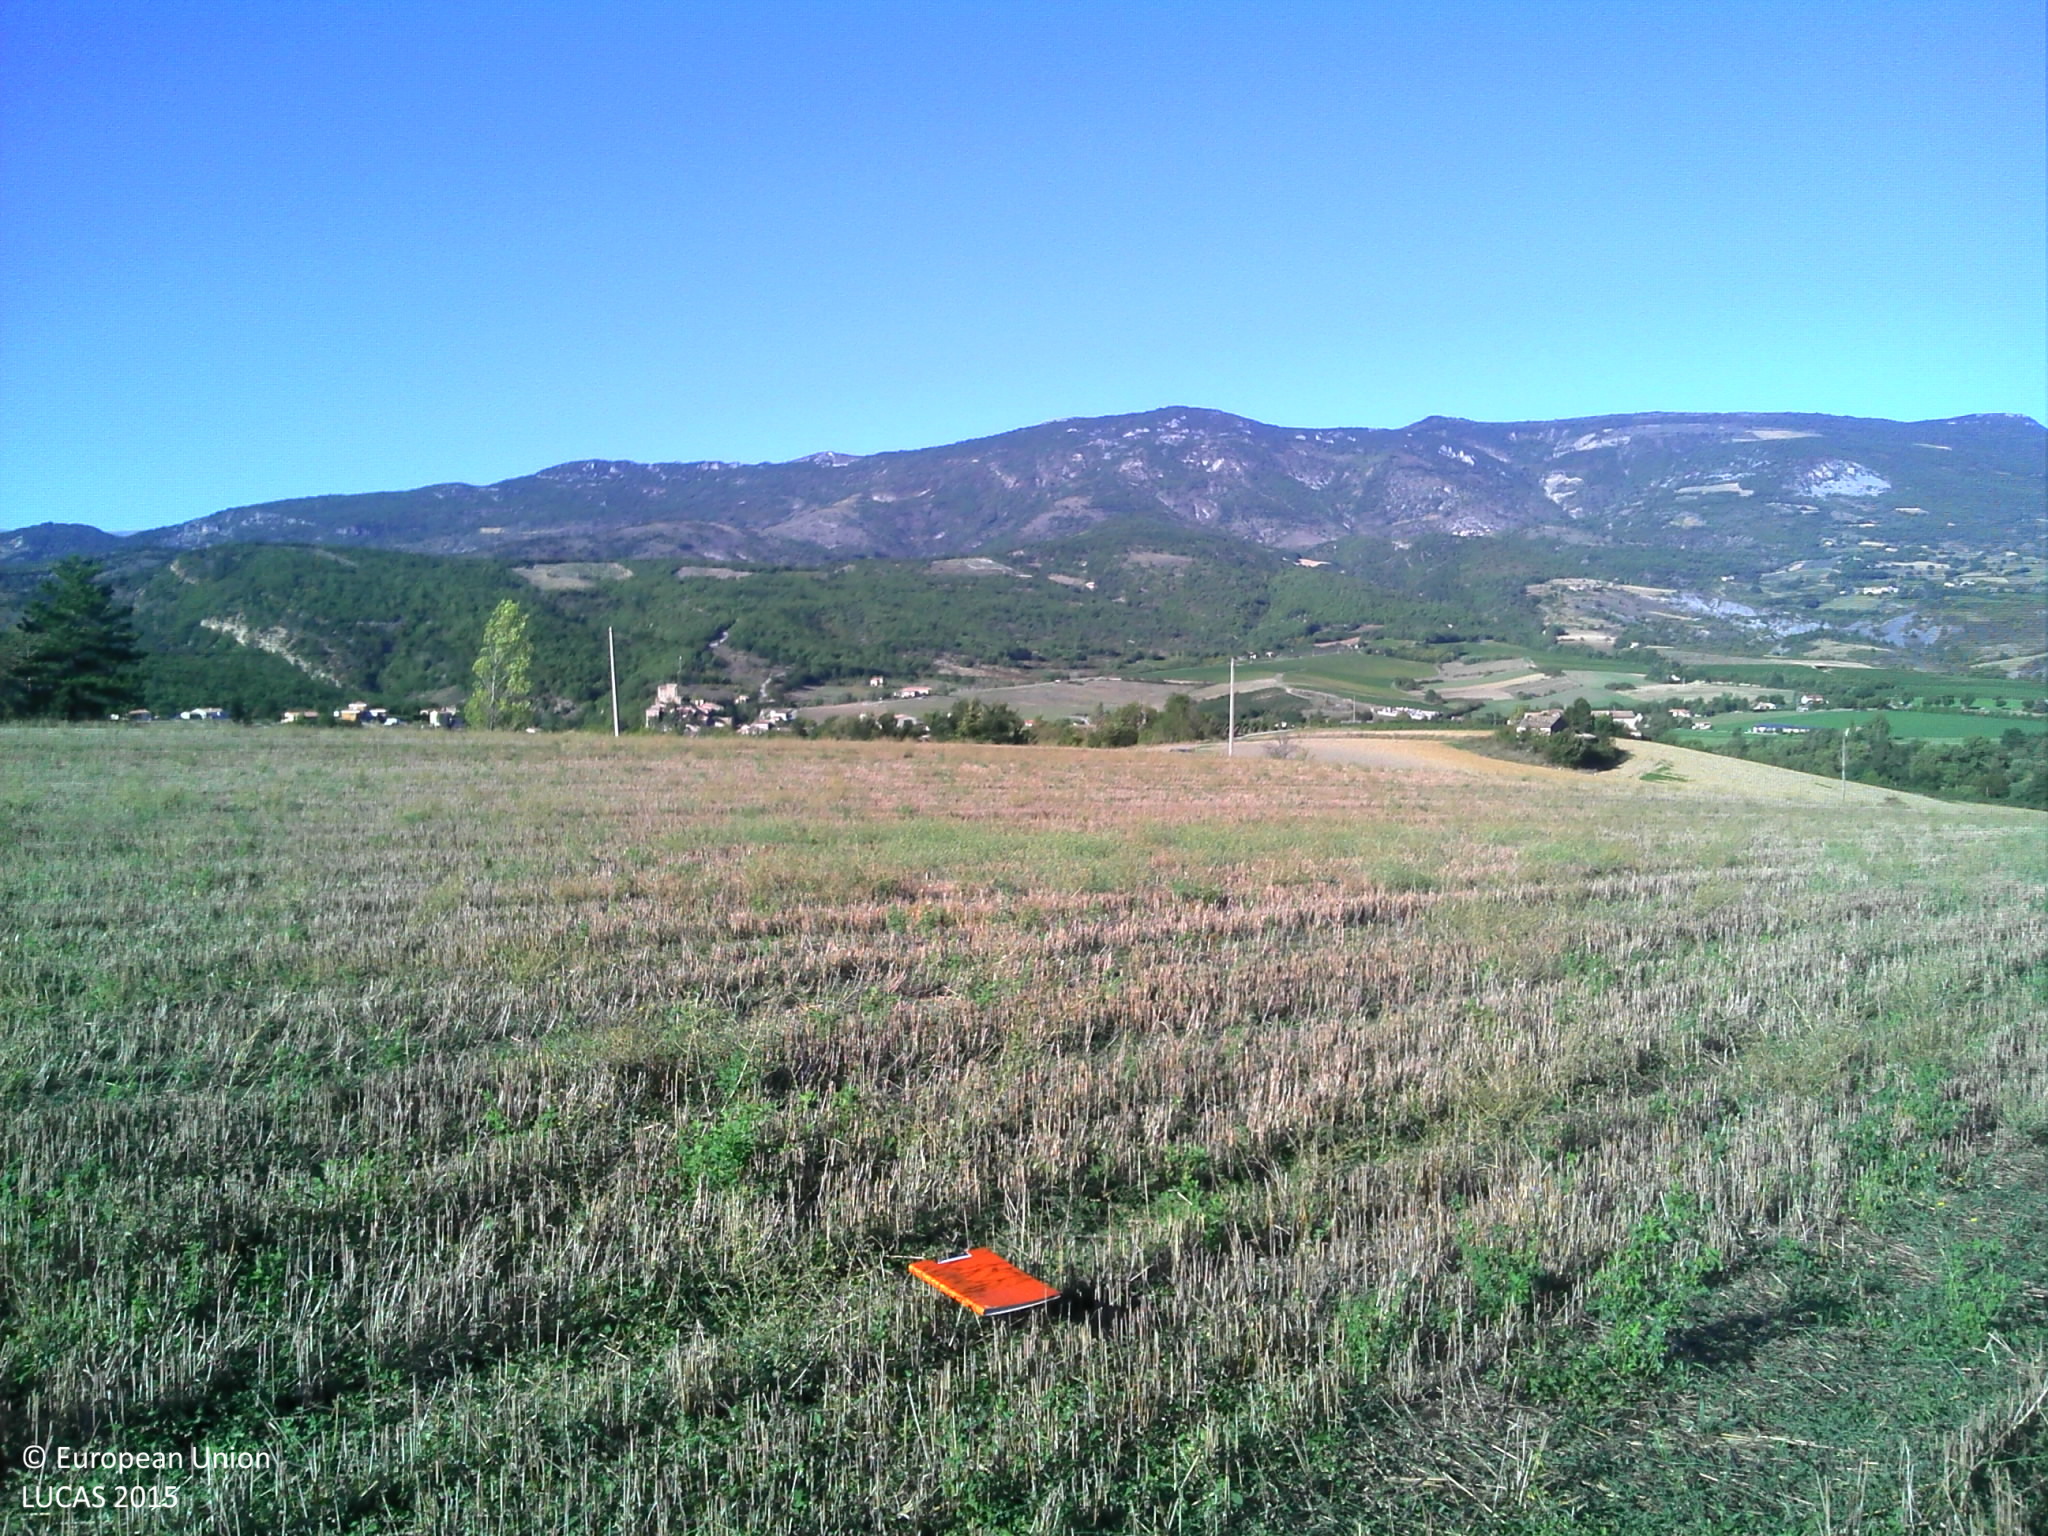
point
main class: Cropland
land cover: Common wheat
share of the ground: > 75 %
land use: Agriculture (excluding fallow land and kitchen gardens)
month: September
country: FR
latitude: 44.3335
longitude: 5.2794
